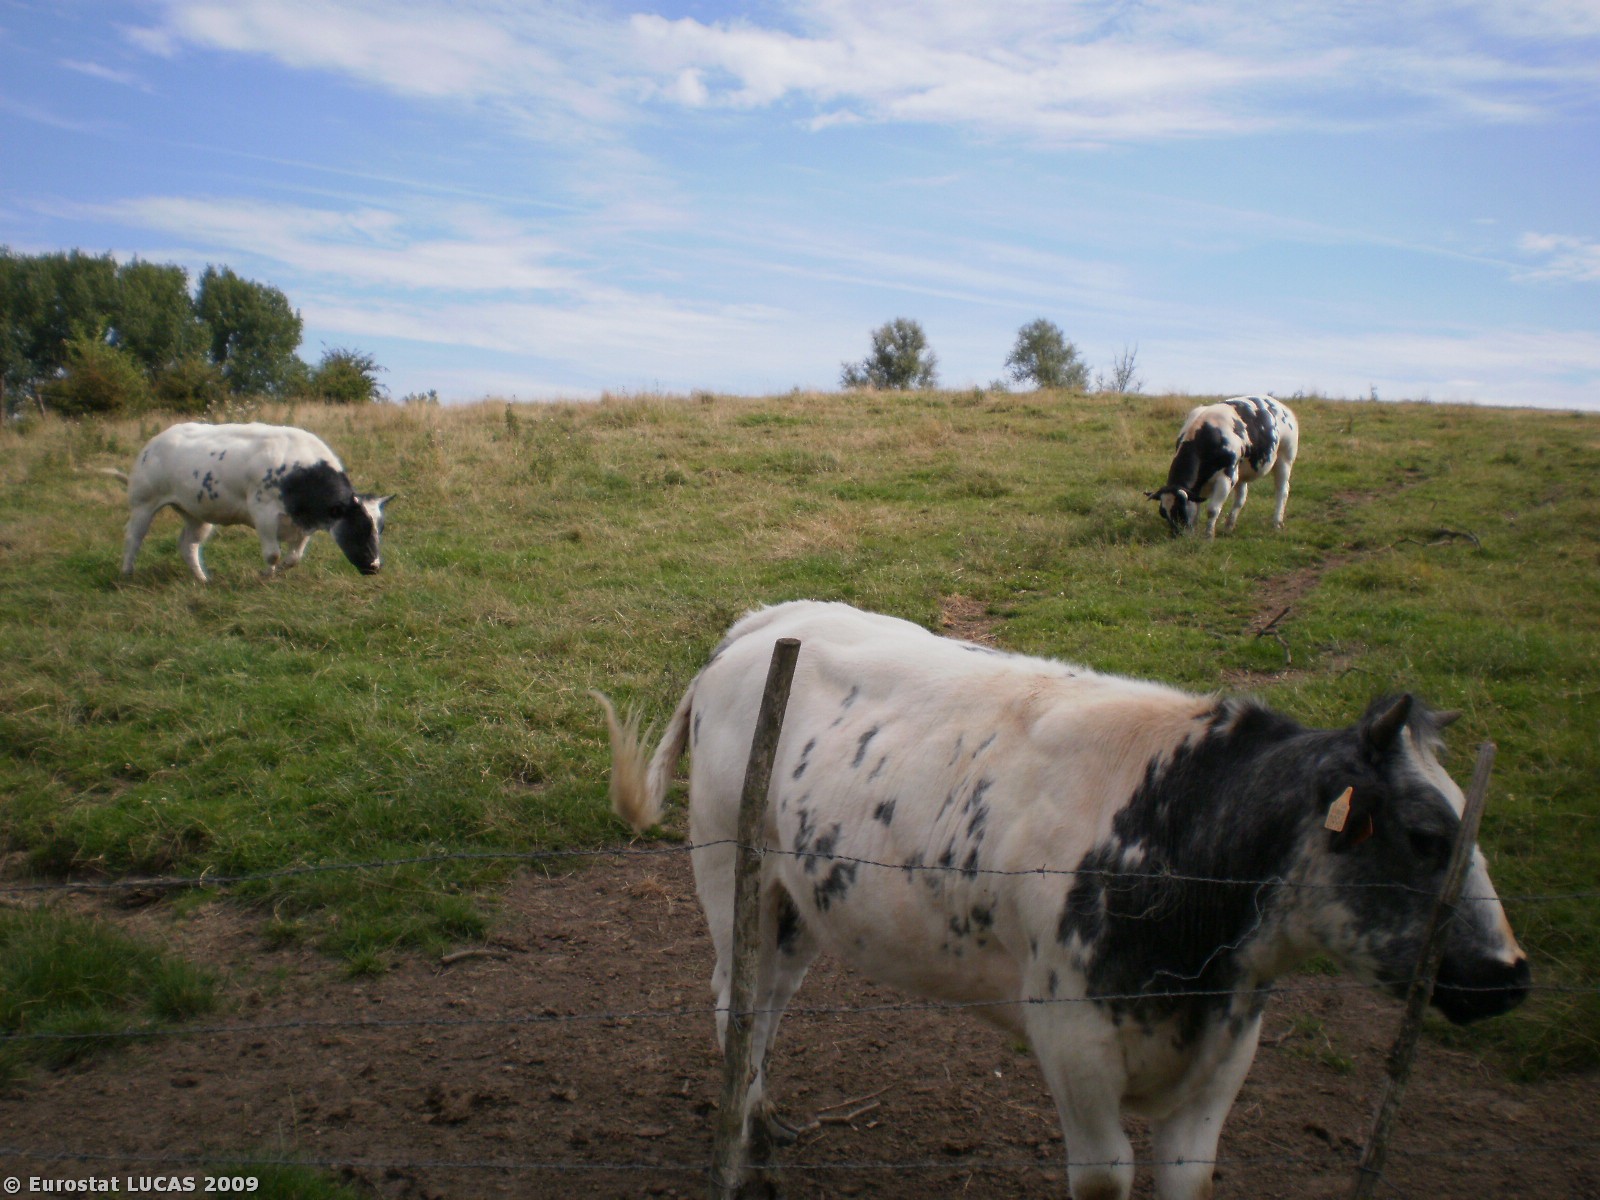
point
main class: Grassland
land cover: Grassland without tree/shrub cover
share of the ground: > 75 %
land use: Agriculture (excluding fallow land and kitchen gardens)
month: August
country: BE
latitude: 50.7354
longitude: 3.7731
